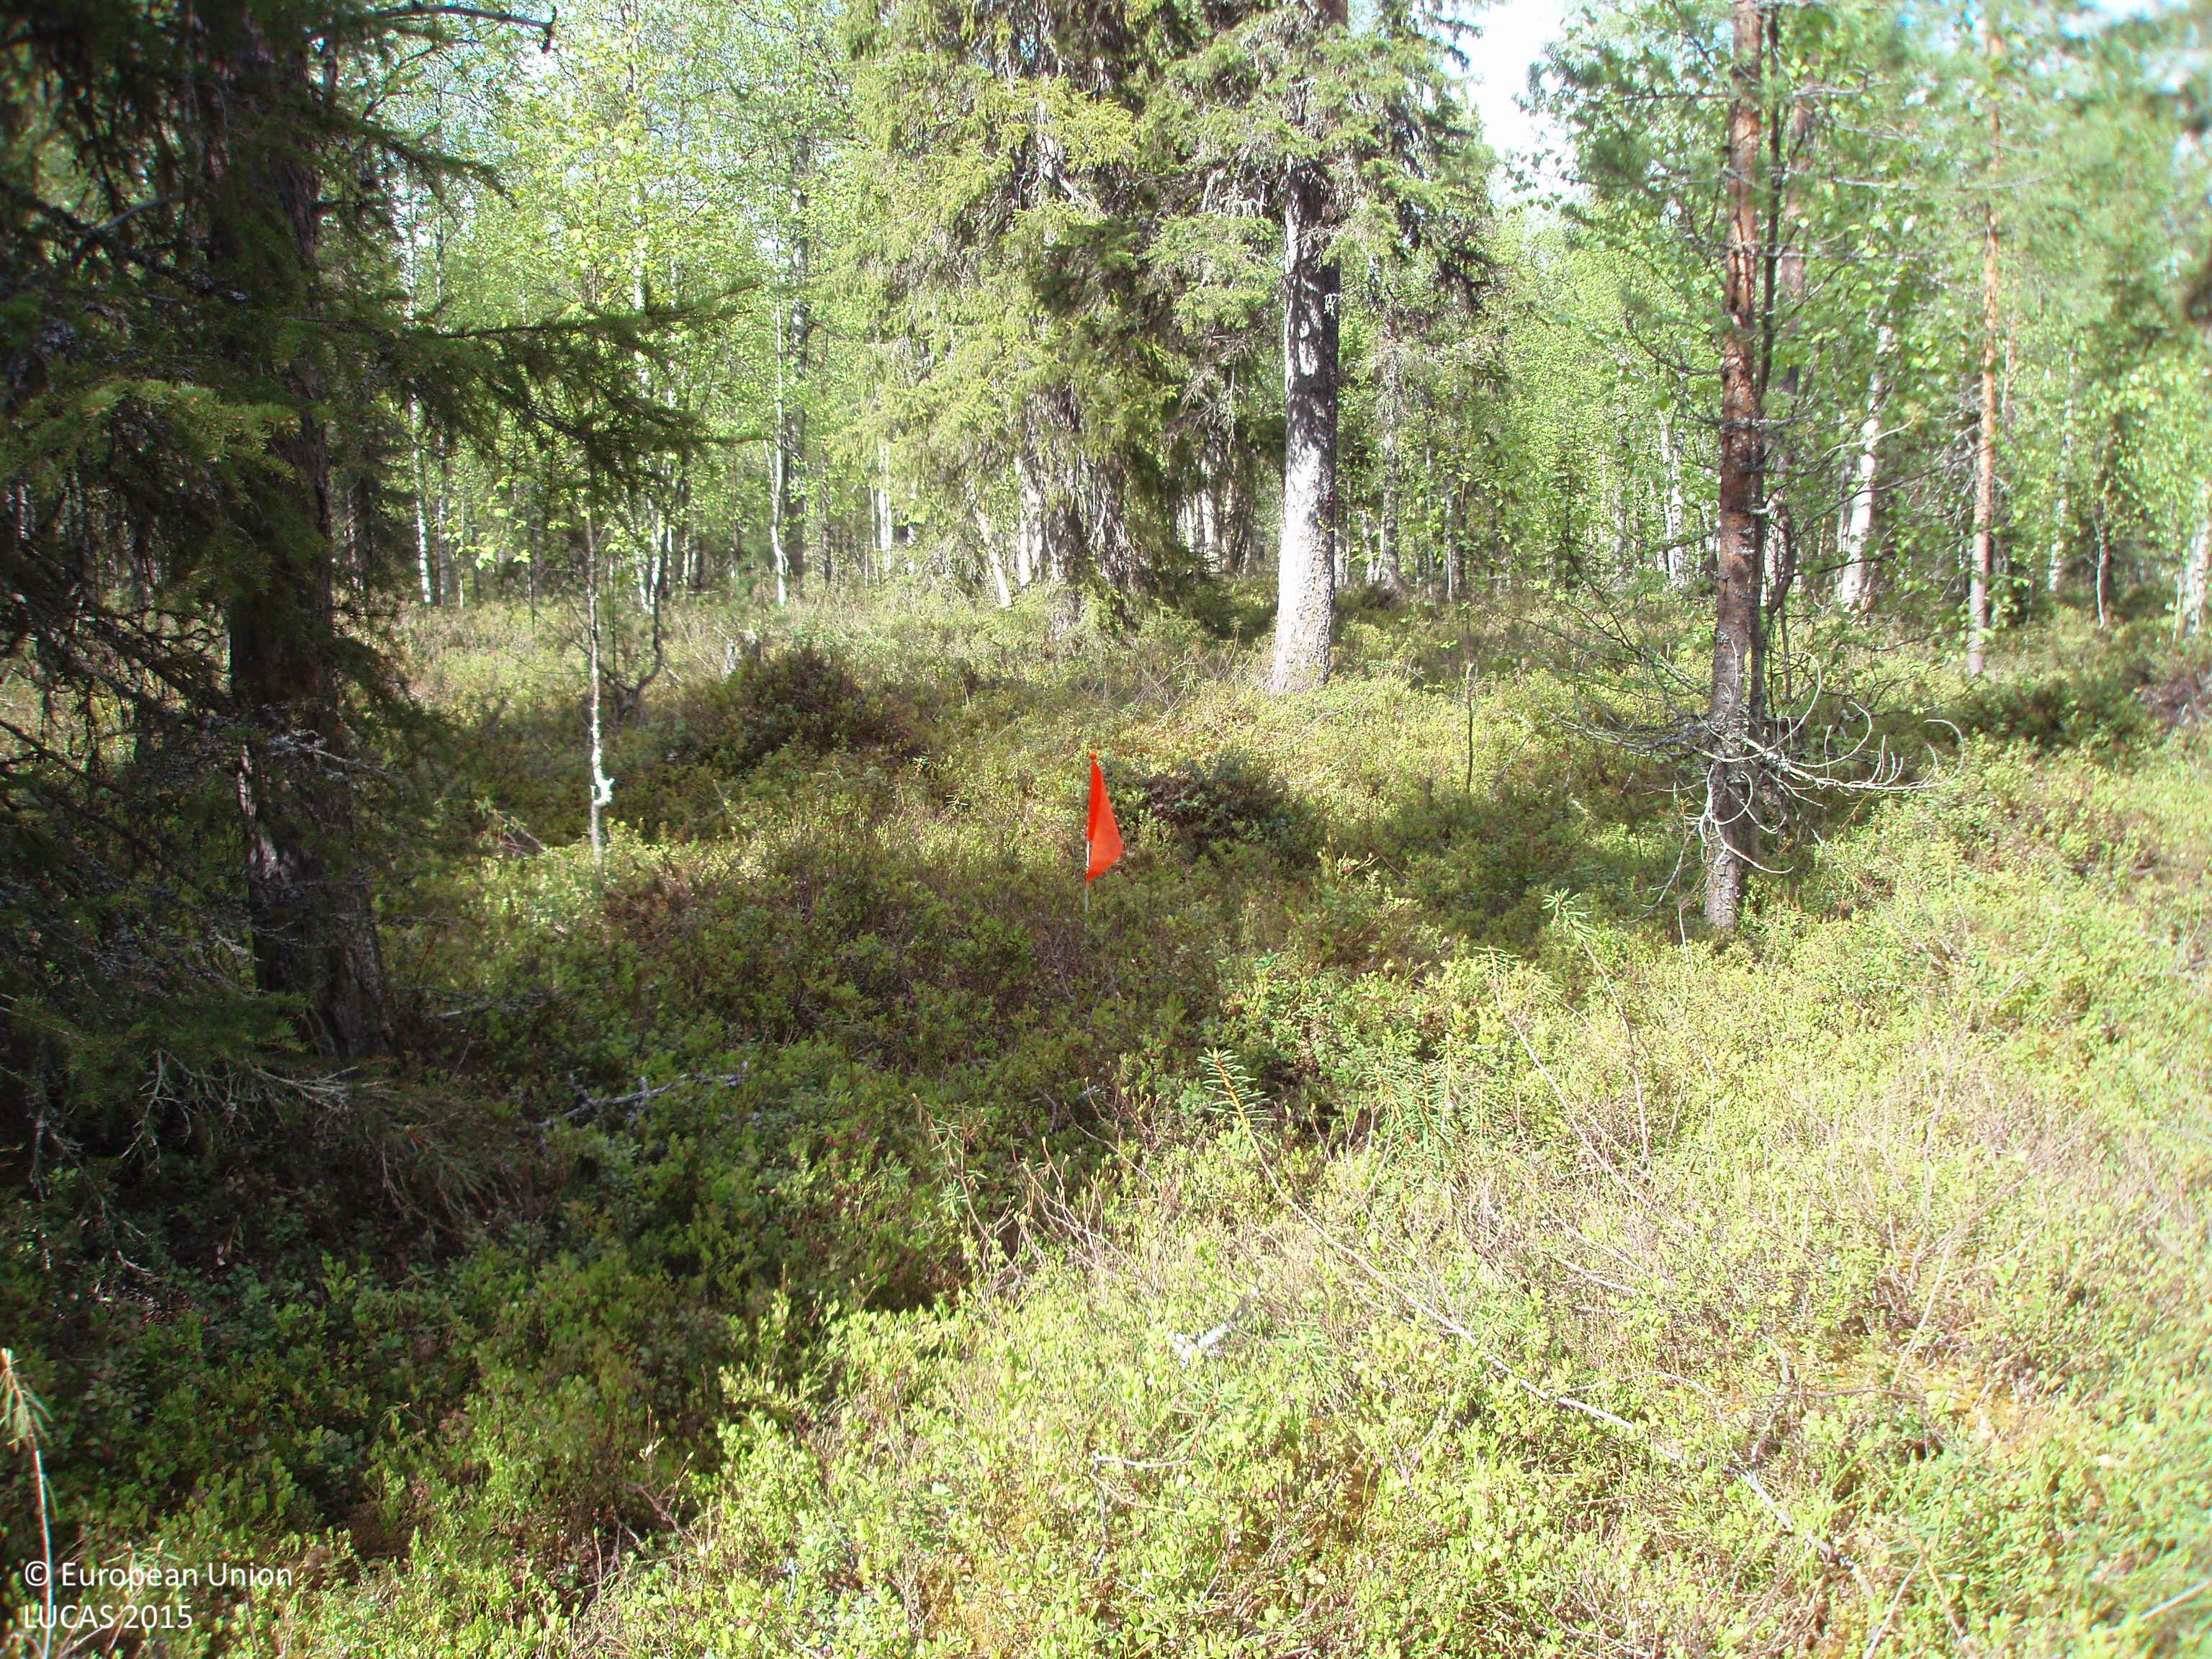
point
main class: Woodland
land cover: Other mixed woodland
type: boreal forest
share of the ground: 50 - 75 %
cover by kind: coniferous forest trees 40 %, broadleaved forest trees 30 %, shrubs 30 %
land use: Forestry
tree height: > 5 m
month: June
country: FI
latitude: 67.0409
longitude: 27.2124
